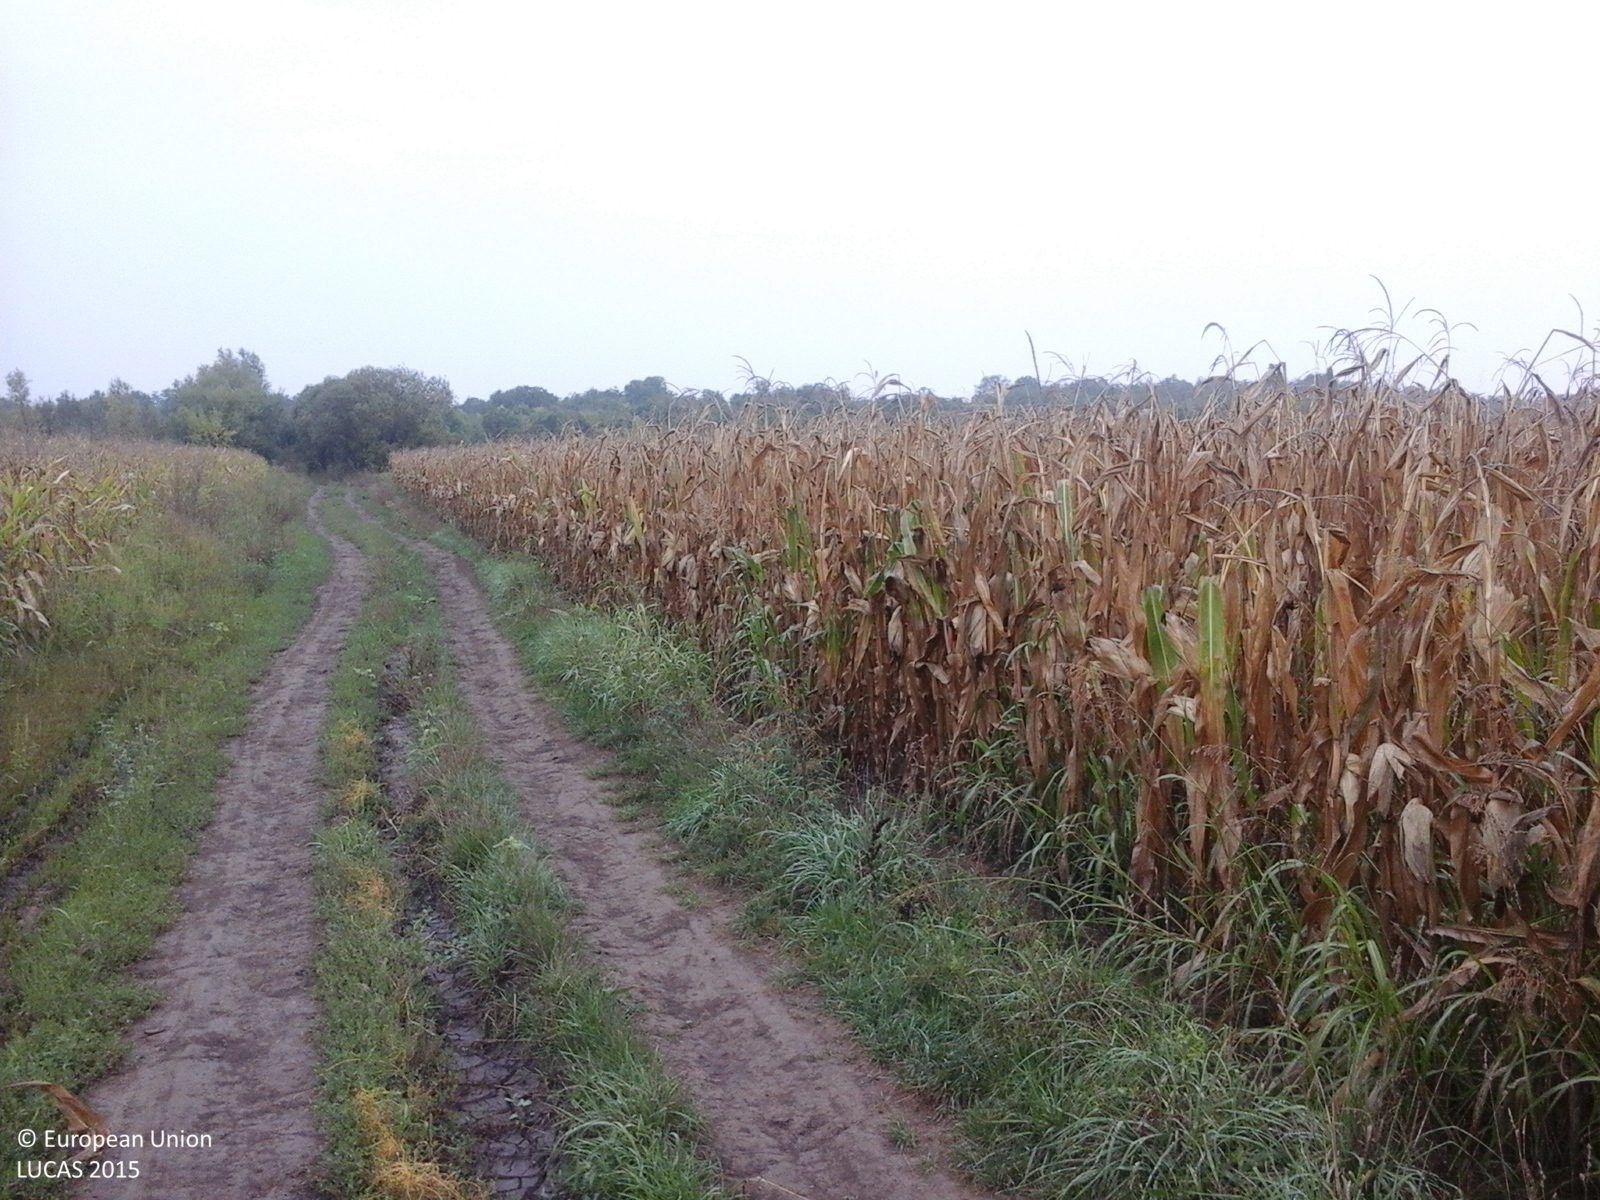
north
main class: Cropland
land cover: Maize
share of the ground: > 75 %
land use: Agriculture (excluding fallow land and kitchen gardens)
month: September
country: RO
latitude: 47.4445
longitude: 22.1053
